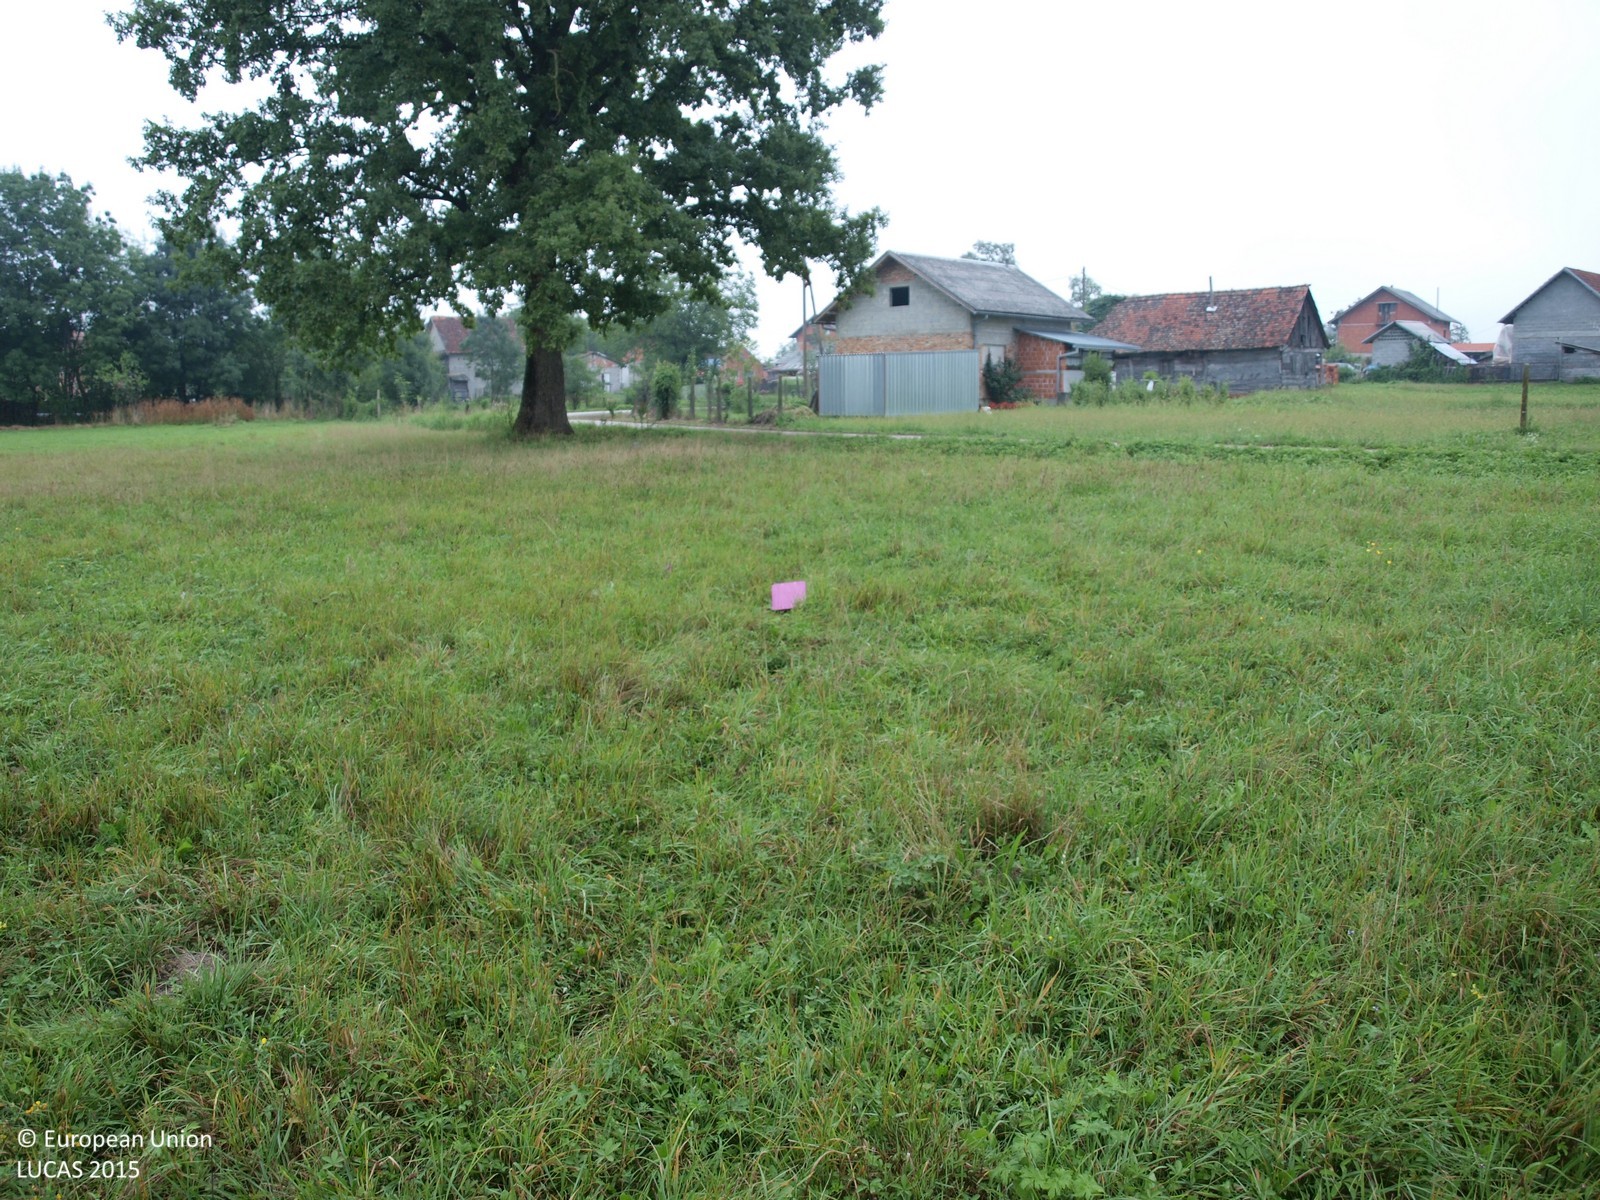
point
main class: Grassland
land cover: Grassland without tree/shrub cover
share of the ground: > 75 %
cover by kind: herbaceous plants 100 %
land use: Agriculture (excluding fallow land and kitchen gardens)
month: August
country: HR
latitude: 45.8047
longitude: 16.2907
